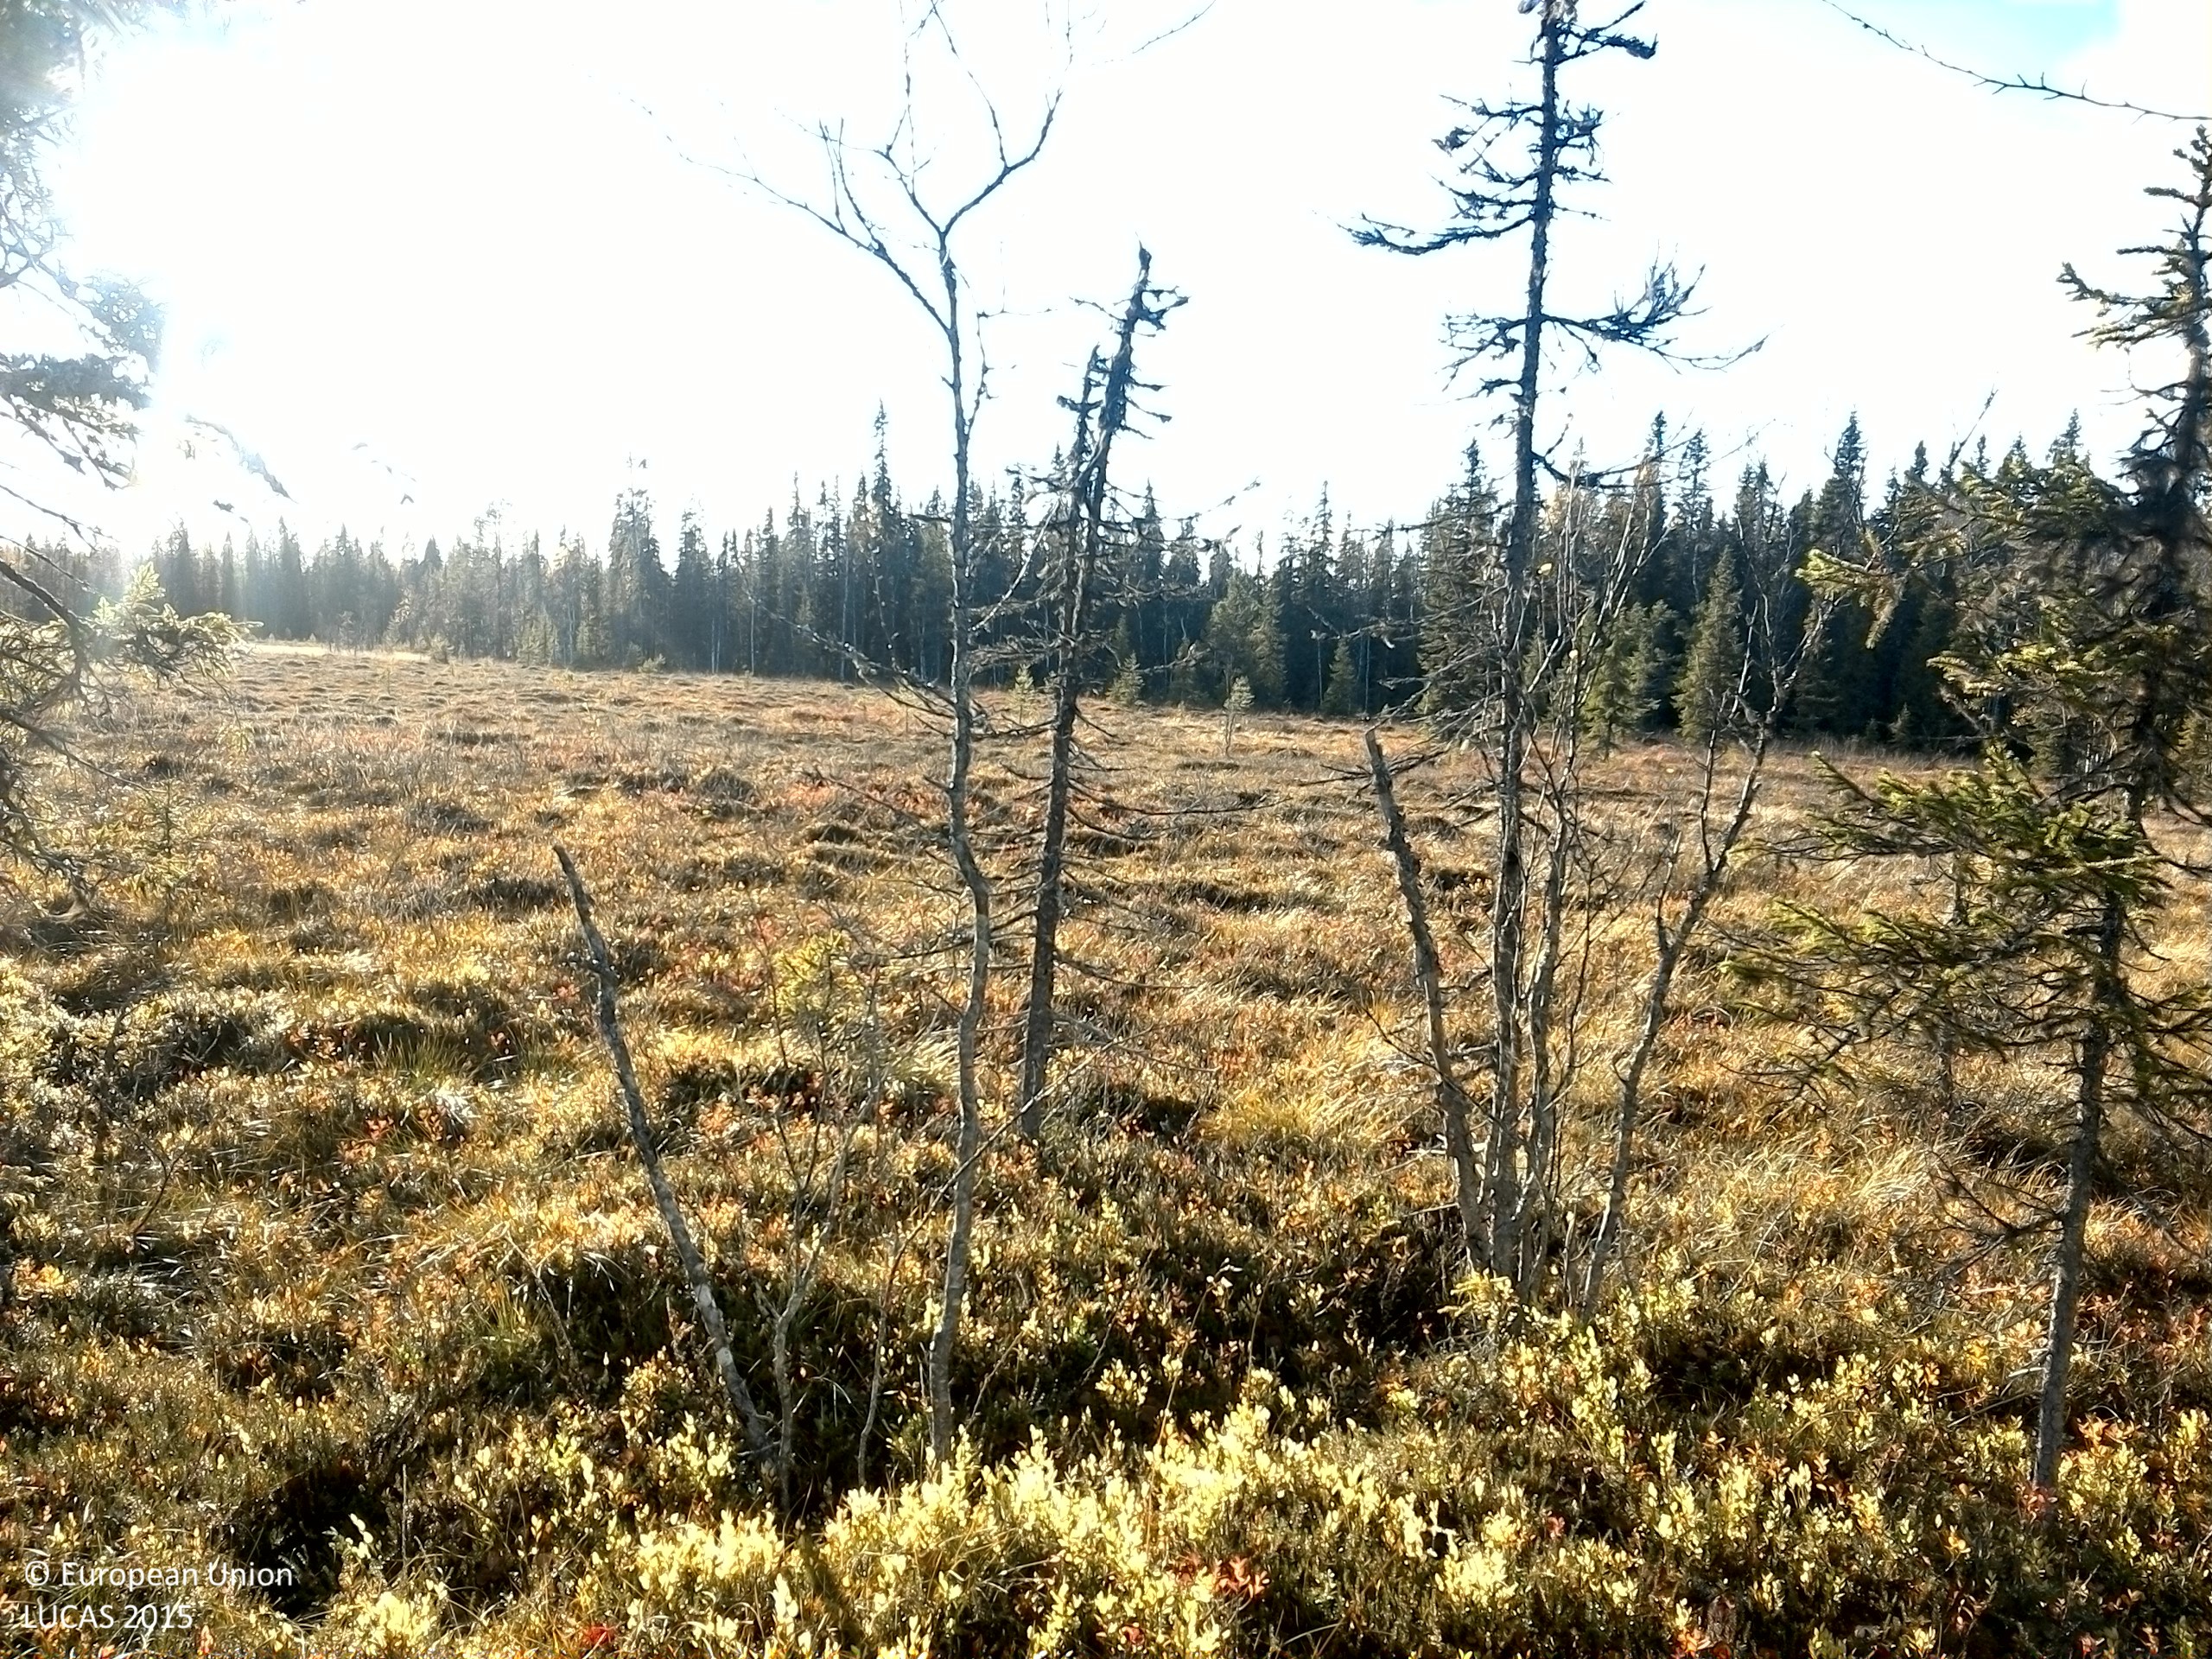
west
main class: Woodland
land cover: Spruce dominated mixed woodland
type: boreal forest
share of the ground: 25 - 50 %
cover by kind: shrubs 45 %, coniferous forest trees 25 %, broadleaved forest trees 15 %, lichens and mosses 15 %
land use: Forestry
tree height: > 5 m
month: October
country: SE
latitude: 64.1909
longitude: 16.0845
